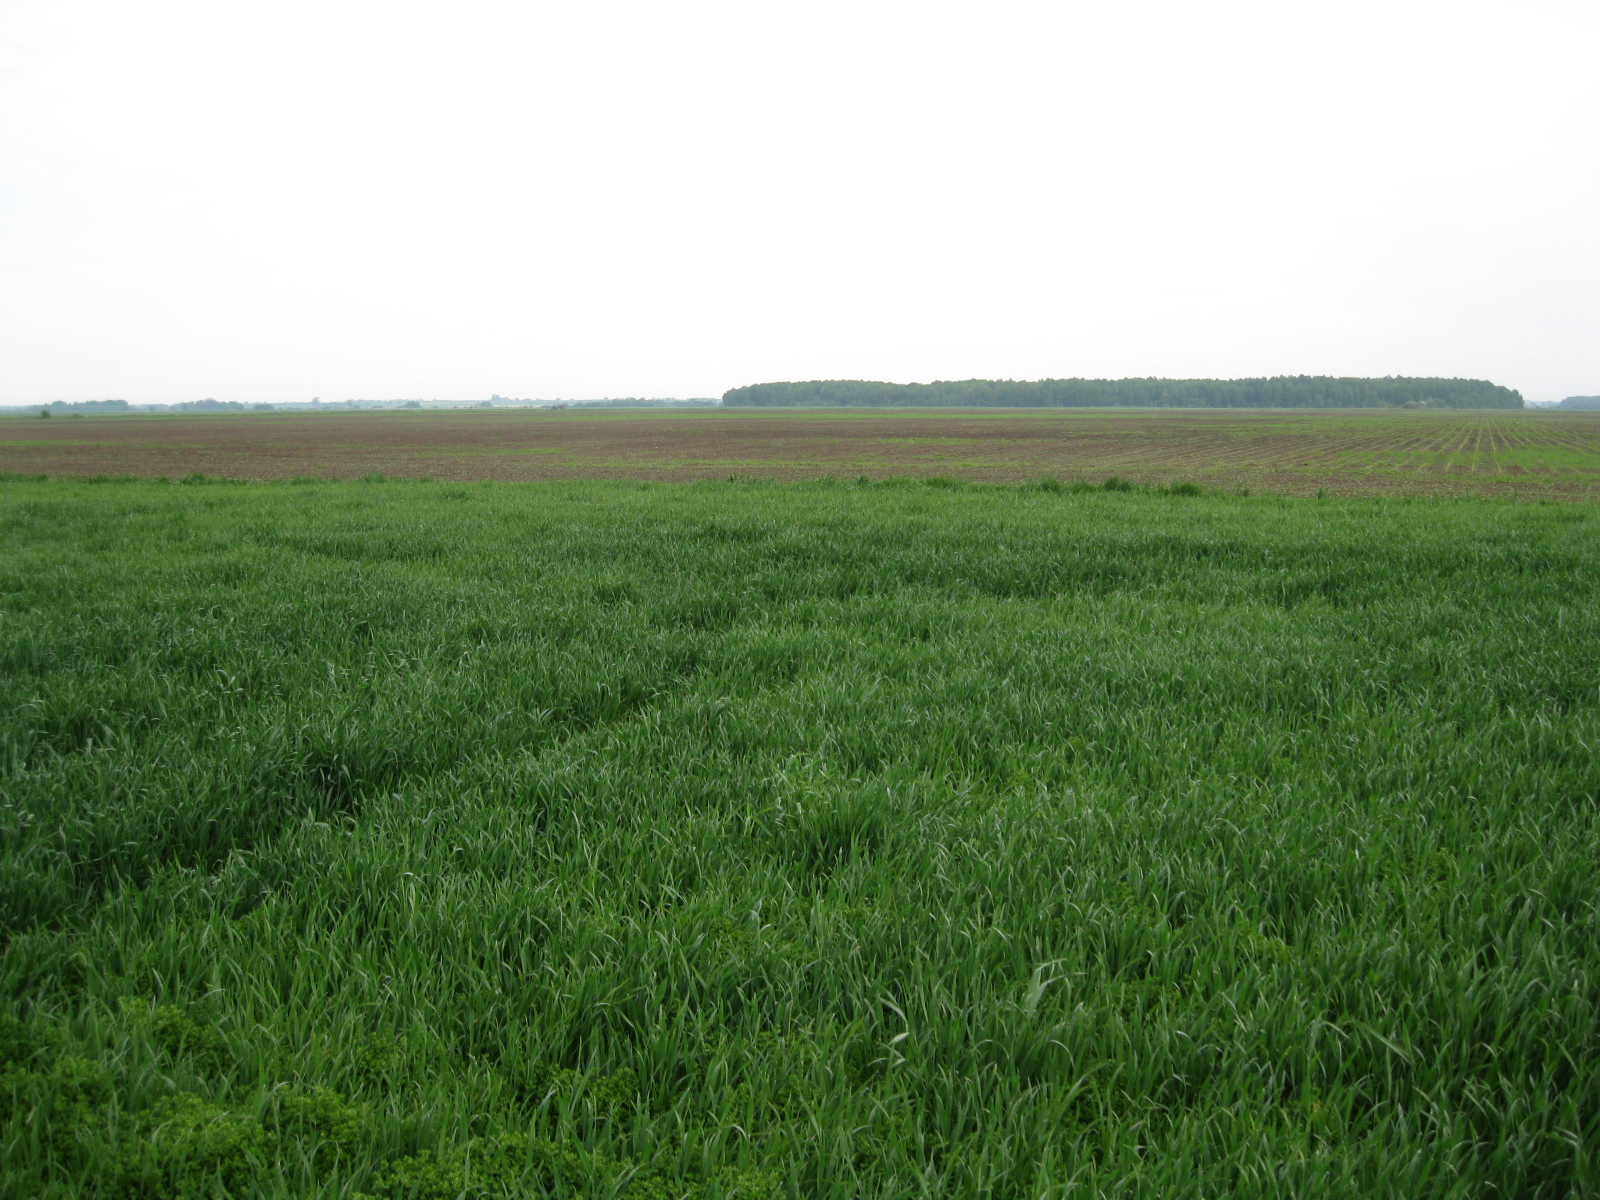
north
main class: Cropland
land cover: Common wheat
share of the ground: > 75 %
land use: Agriculture (excluding fallow land and kitchen gardens)
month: May
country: LT
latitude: 56.0116
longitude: 23.8951
